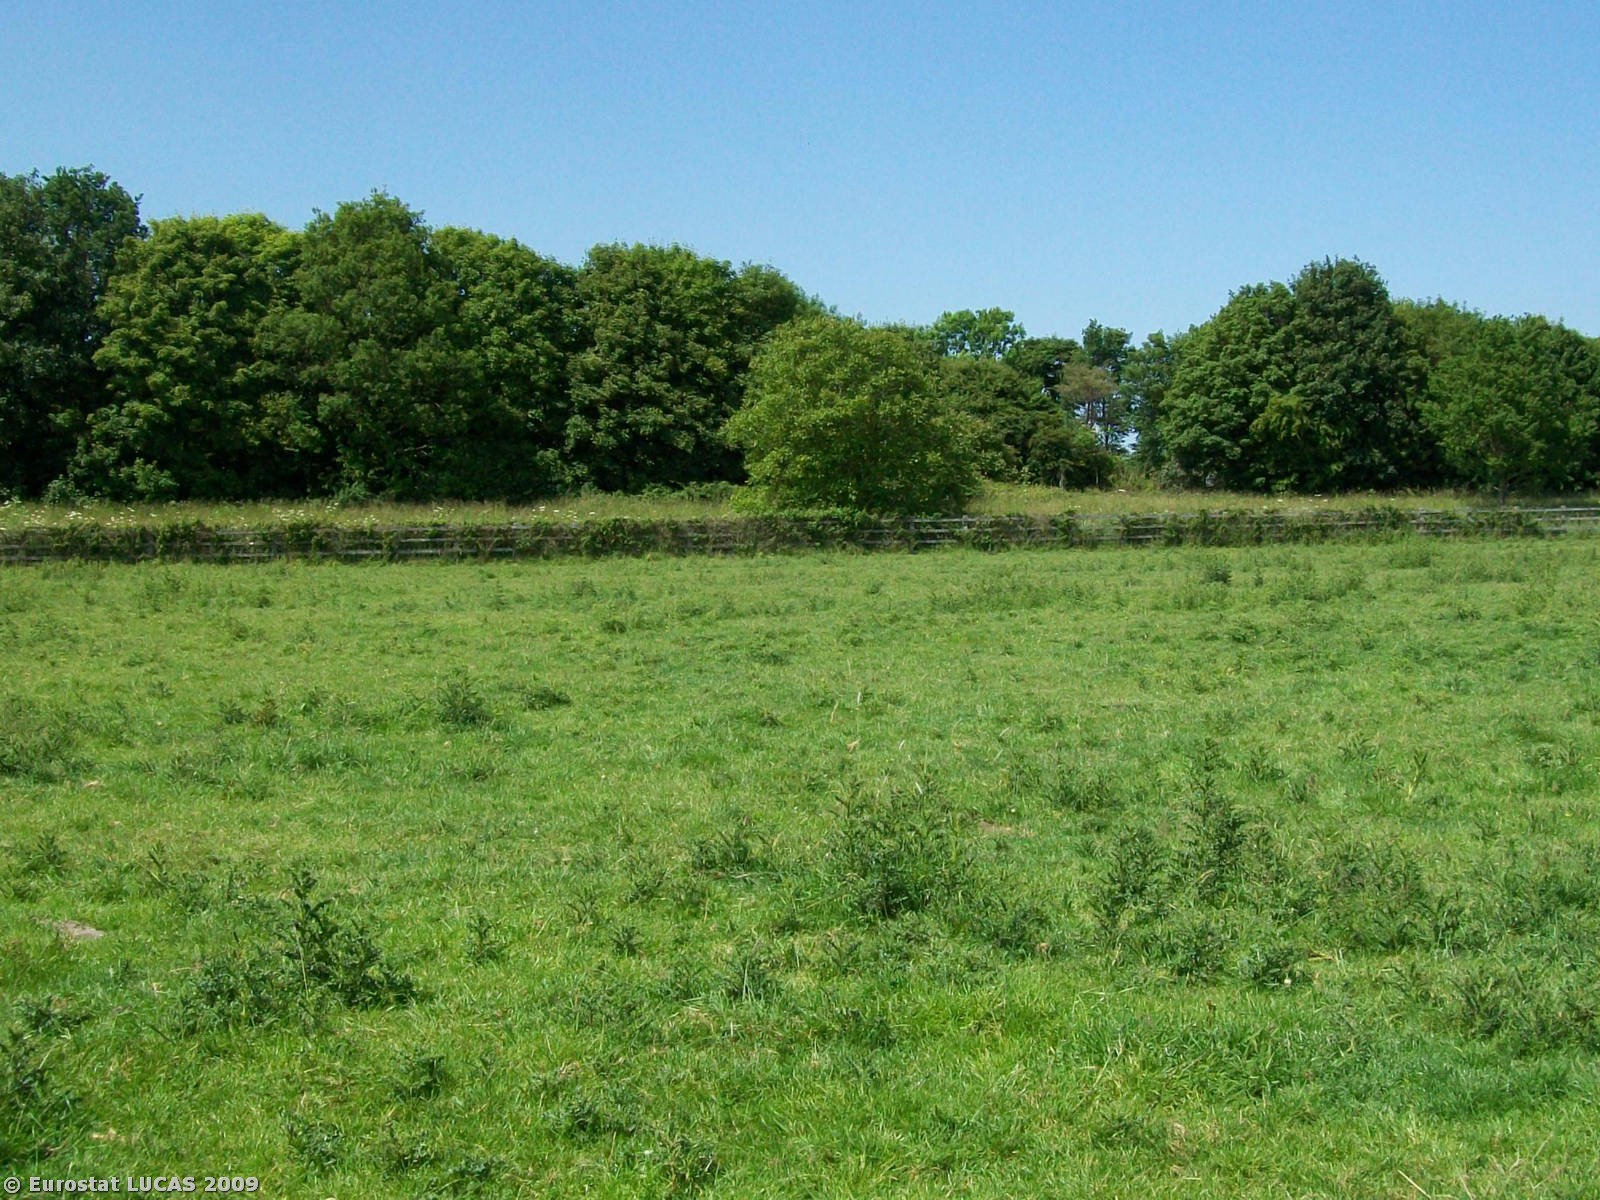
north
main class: Grassland
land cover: Grassland without tree/shrub cover
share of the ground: > 75 %
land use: Agriculture (excluding fallow land and kitchen gardens)
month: June
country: GB
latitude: 51.0228
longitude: -2.6576
